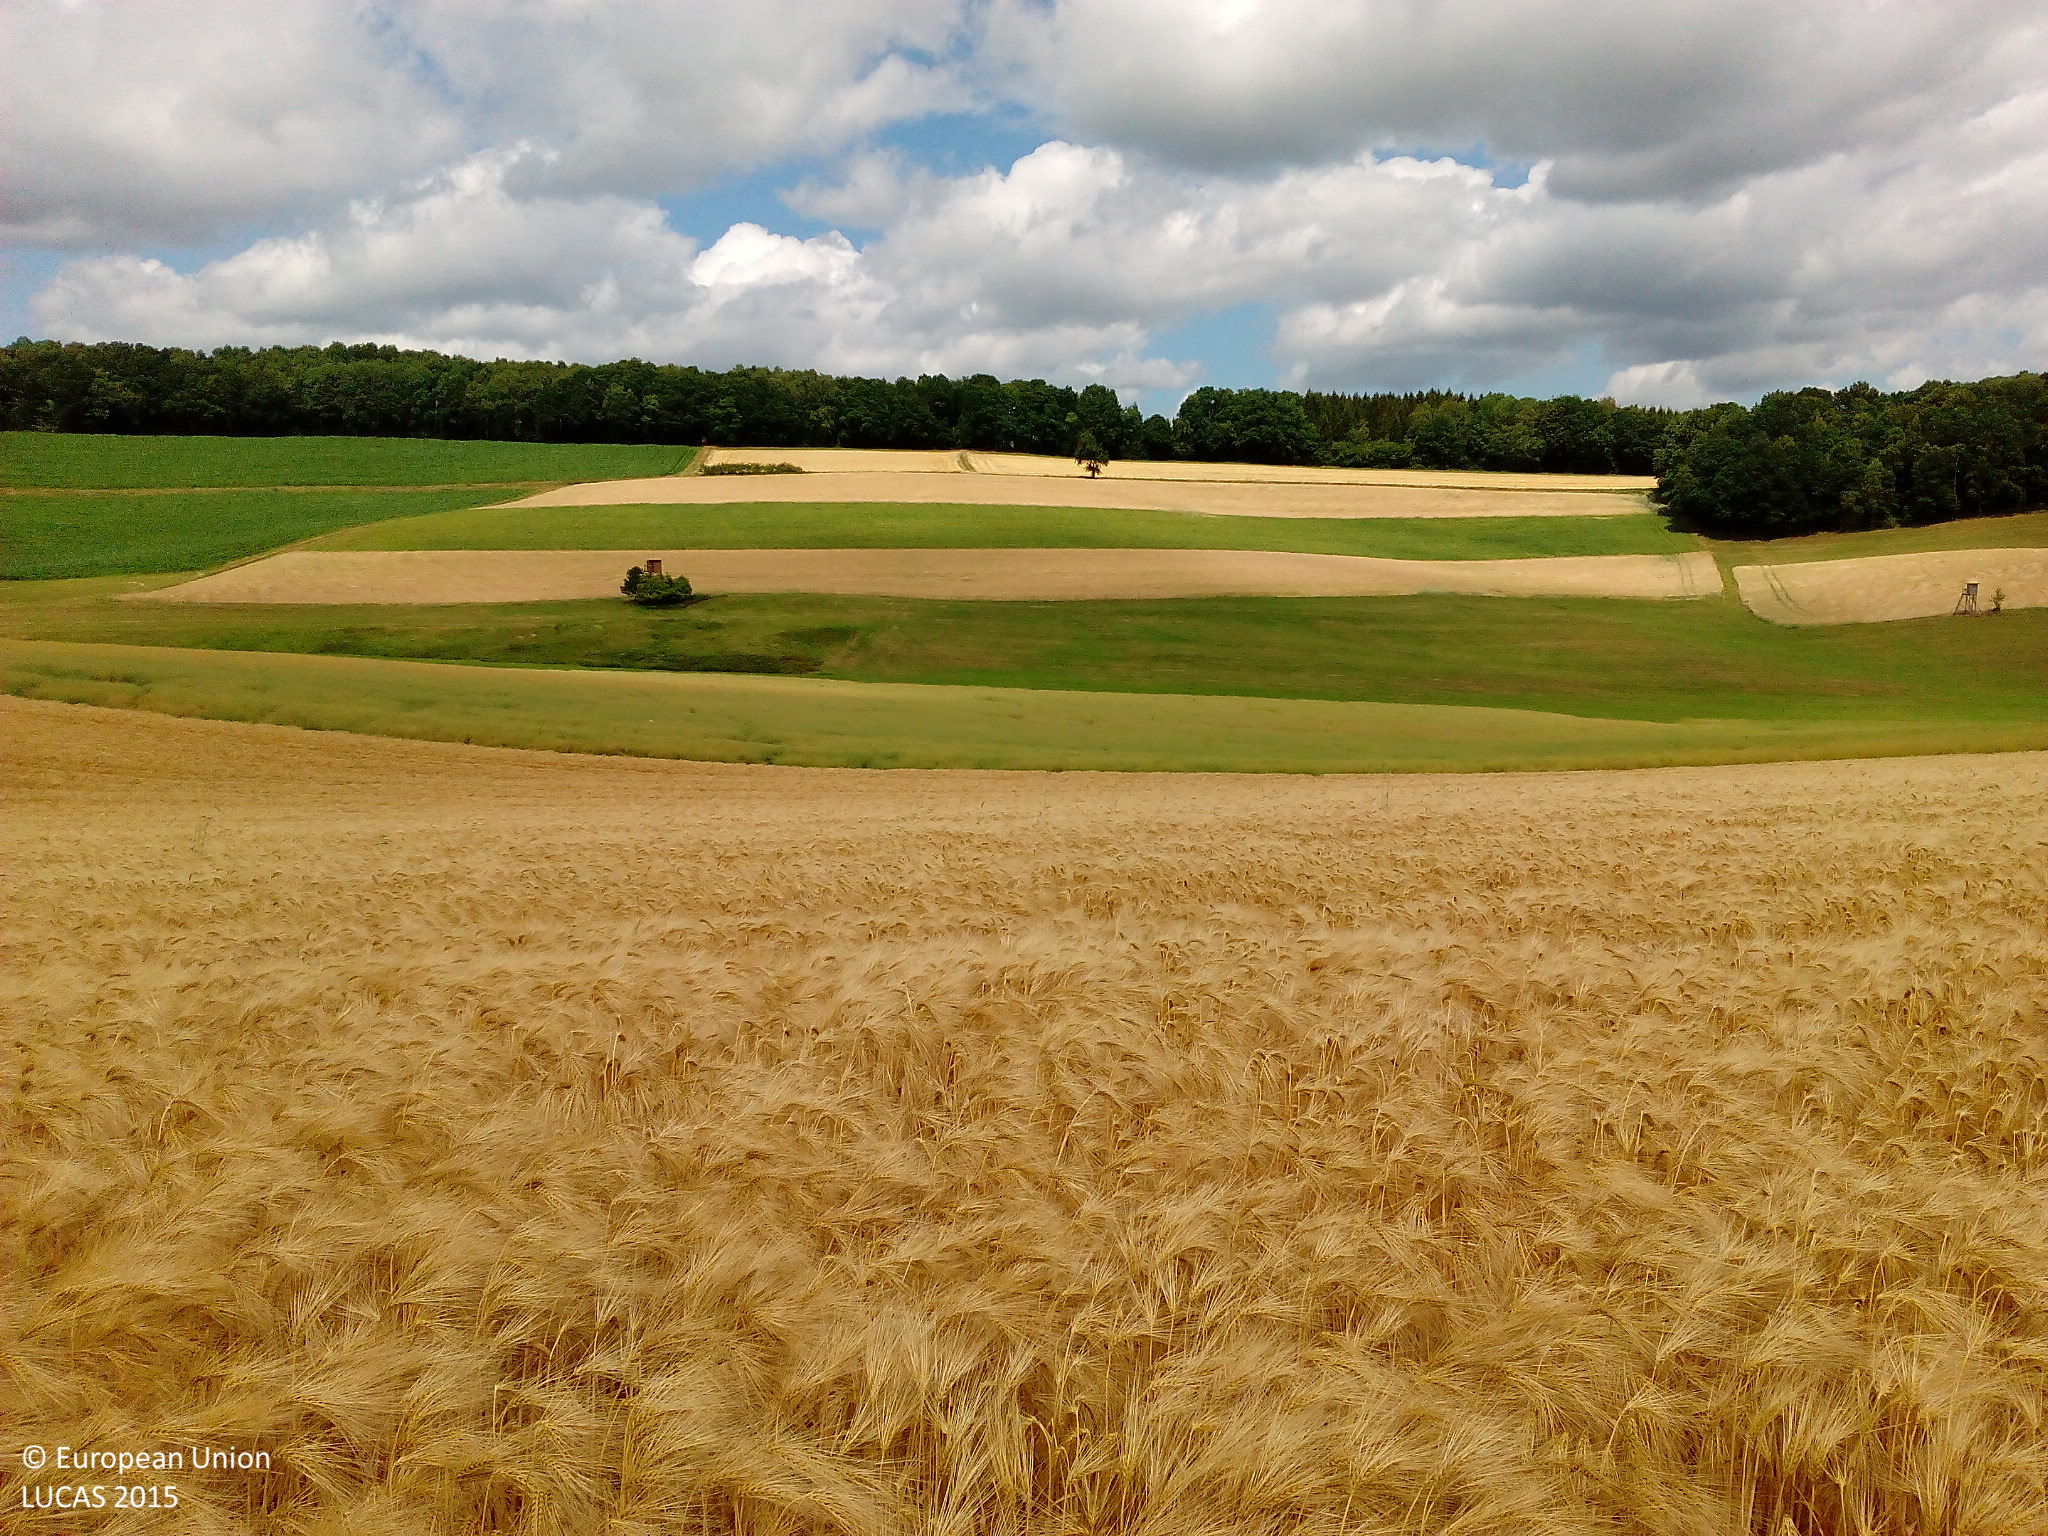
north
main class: Cropland
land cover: Barley
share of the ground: > 75 %
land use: Agriculture (excluding fallow land and kitchen gardens)
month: July
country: DE
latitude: 51.0651
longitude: 9.8431
